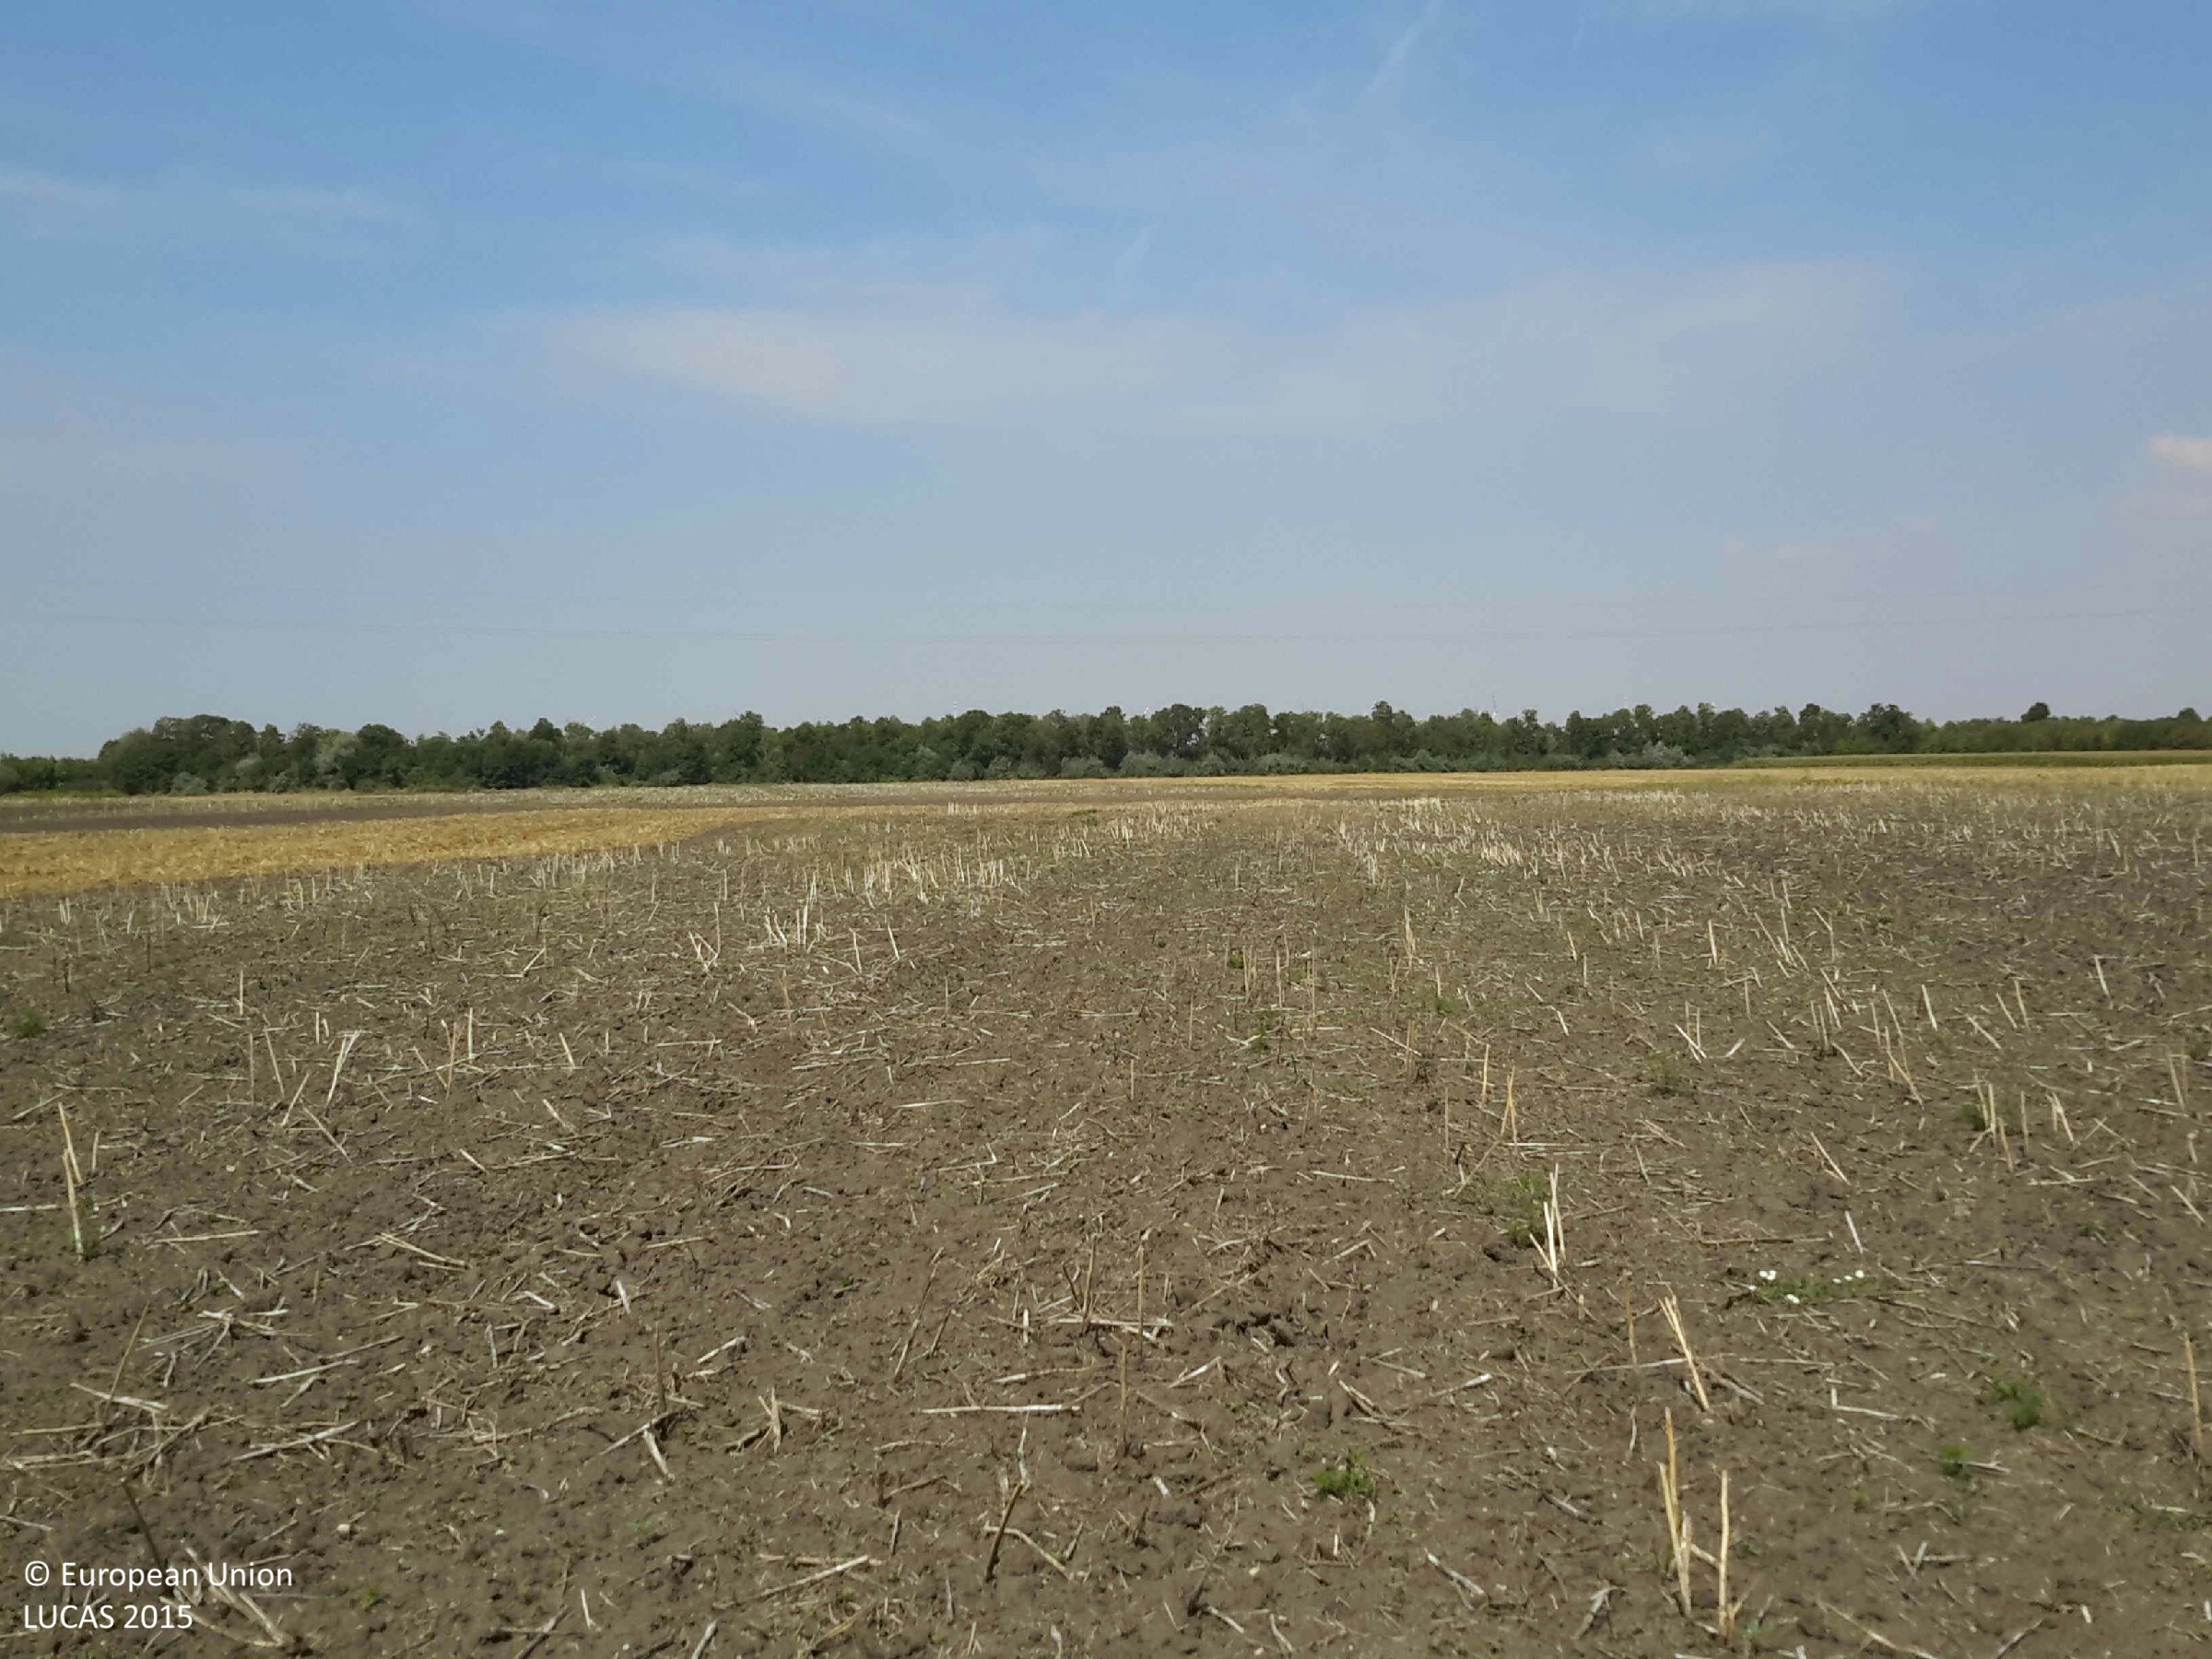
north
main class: Cropland
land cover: Rape and turnip rape
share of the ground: < 10 %
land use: Agriculture (excluding fallow land and kitchen gardens)
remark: Harvested field
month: August
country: HU
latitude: 47.7585
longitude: 17.1175
